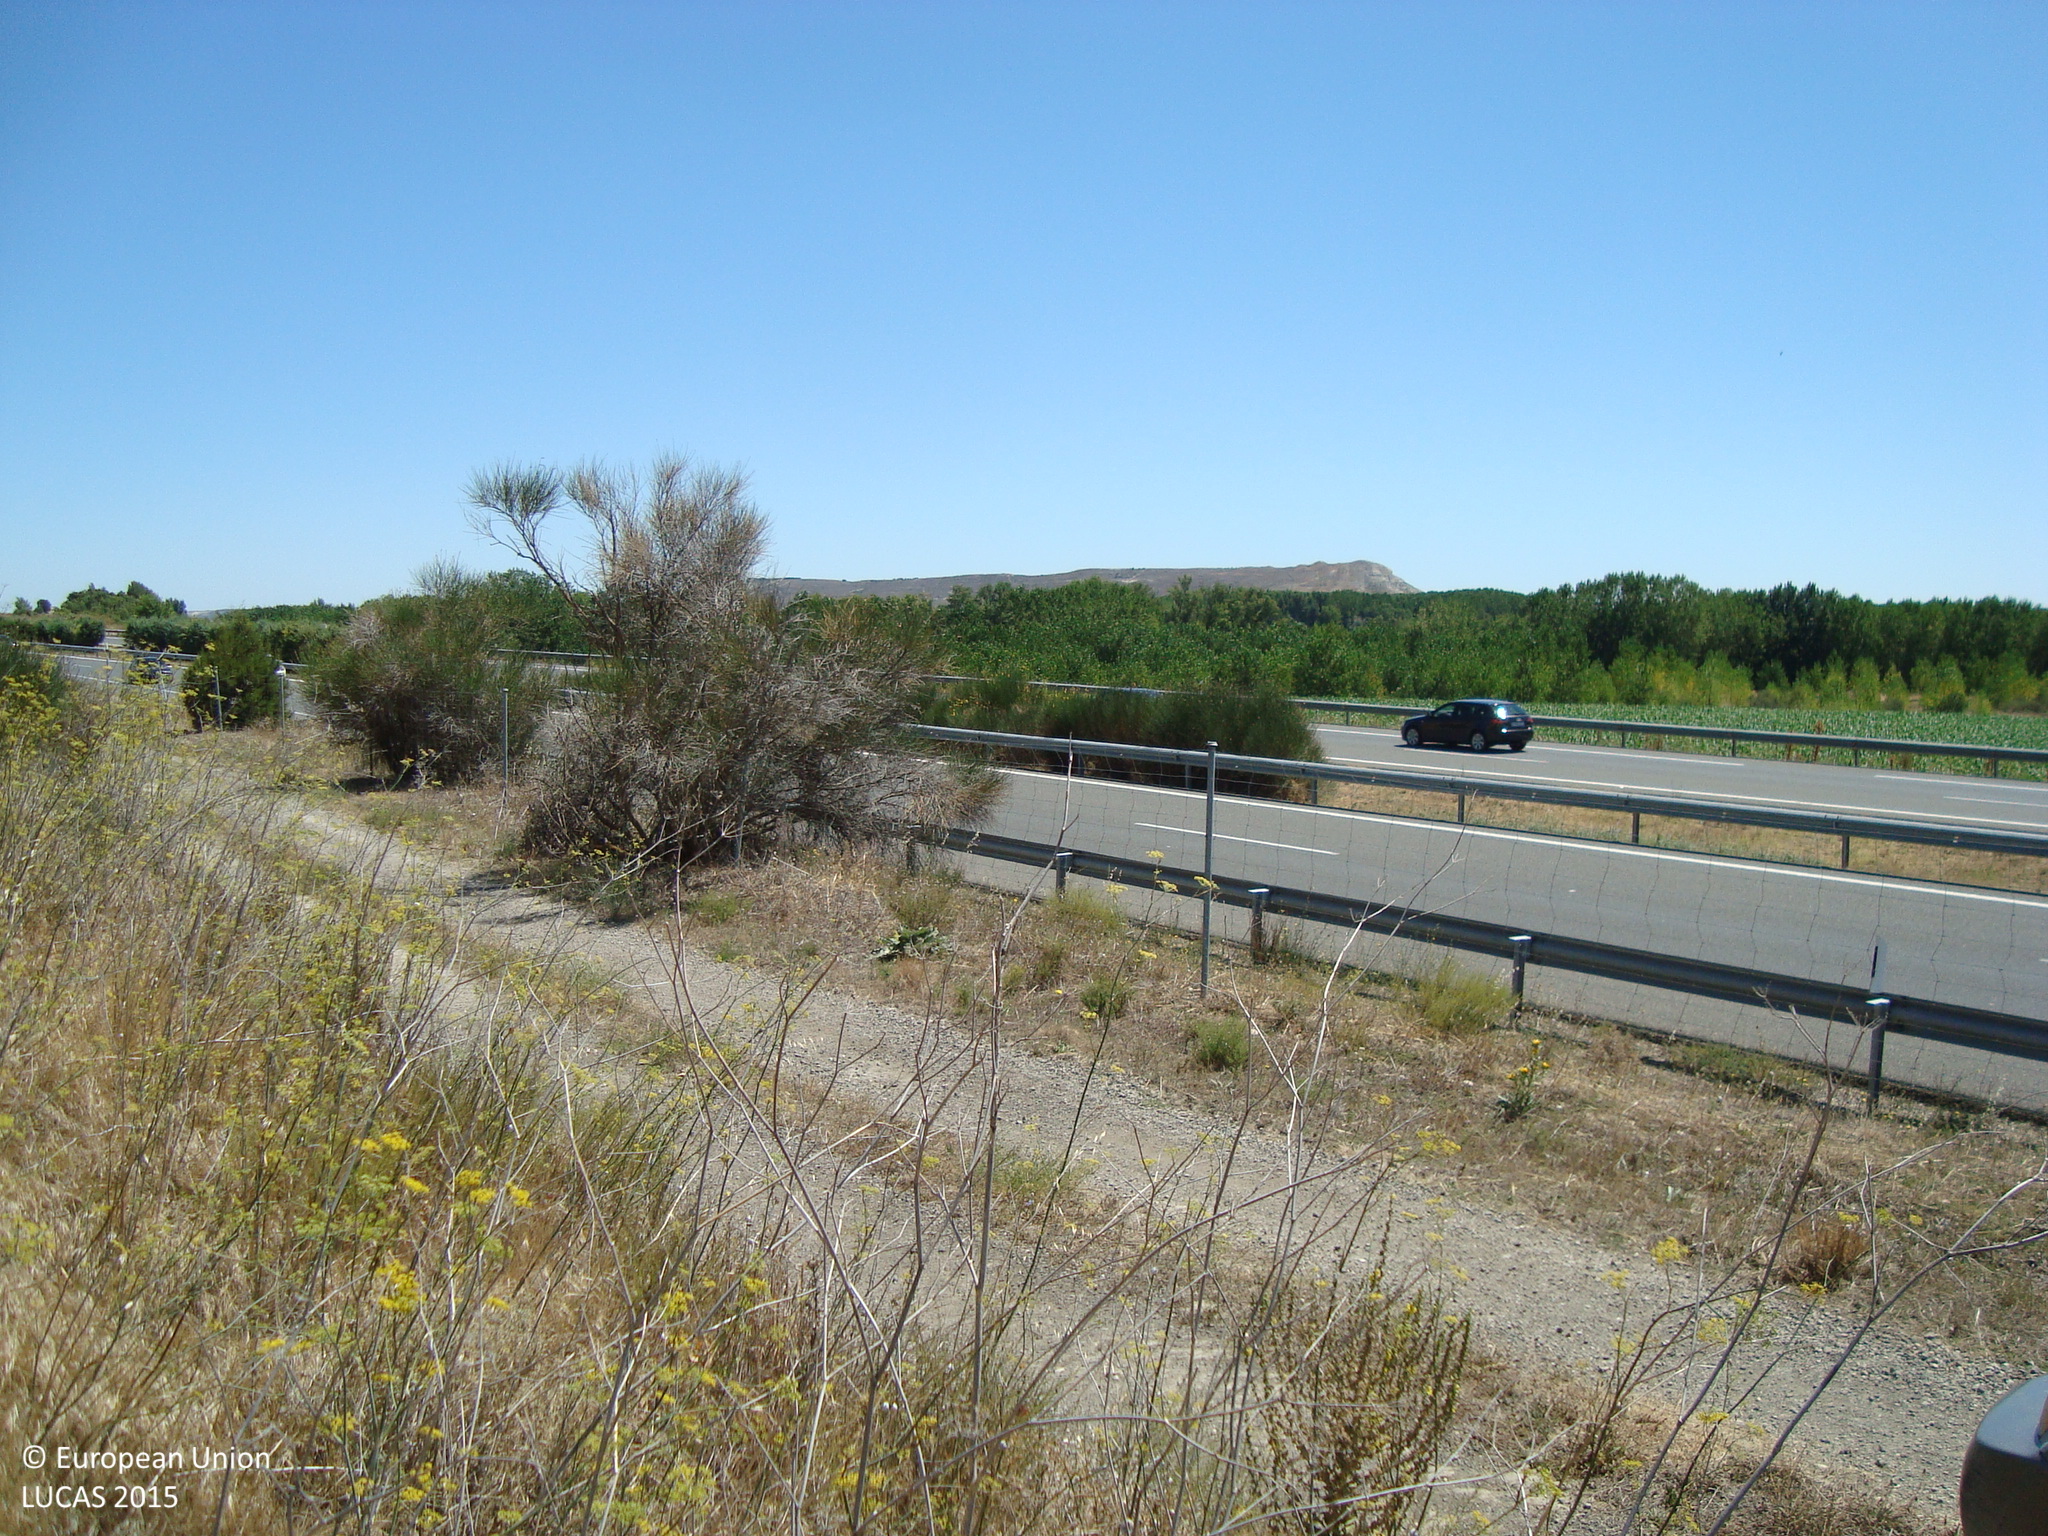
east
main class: Cropland
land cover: Barley
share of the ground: > 75 %
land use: Agriculture (excluding fallow land and kitchen gardens)
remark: Harvested field
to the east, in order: Barley; Lines of trees; Tracks; Grass margins; Fences; Grass margins; Tracks; Grass margins; Paved roads, cycling and walking lanes; Grassland without tree/shrub cover; Ditches and canals; Managed hedges; Grassland without tree/shrub cover
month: August
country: ES
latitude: 42.1086
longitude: -4.1784
